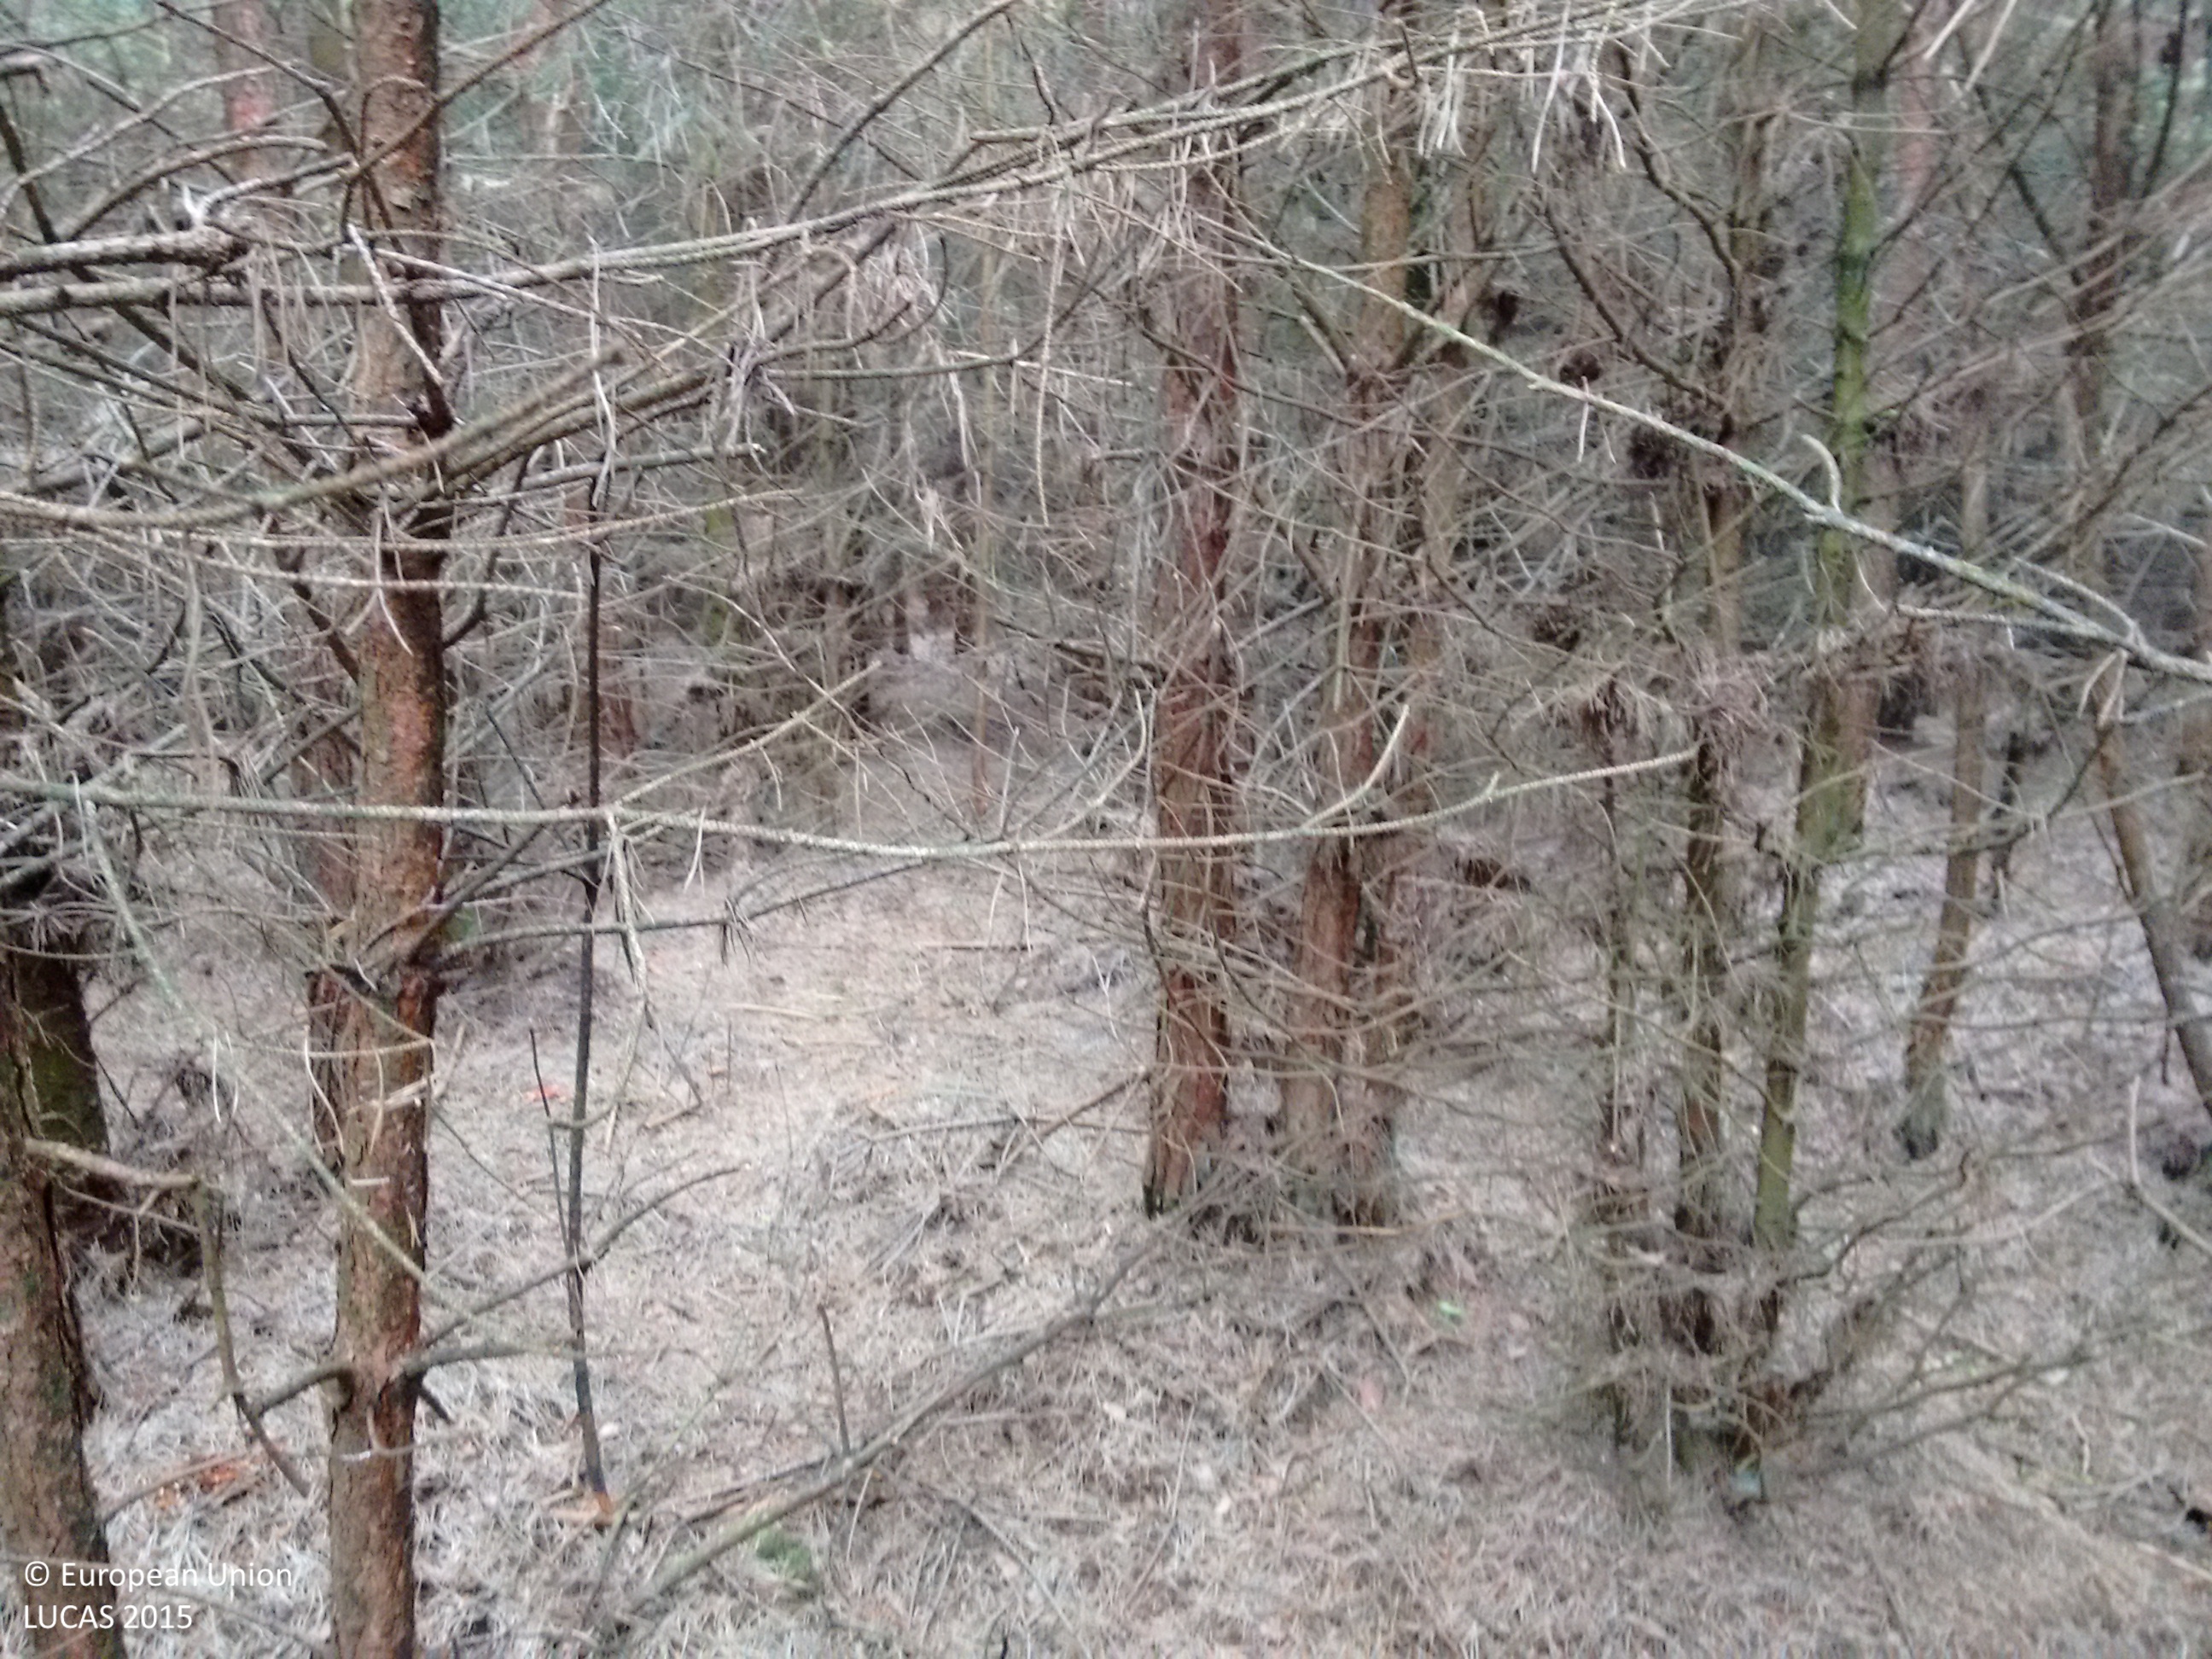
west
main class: Woodland
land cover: Pine dominated coniferous woodland
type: exotic forest
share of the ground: > 75 %
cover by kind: coniferous forest trees 80 %, broadleaved forest trees 20 %
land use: Forestry
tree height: > 5 m
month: June
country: GB
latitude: 54.3107
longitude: -0.8455
